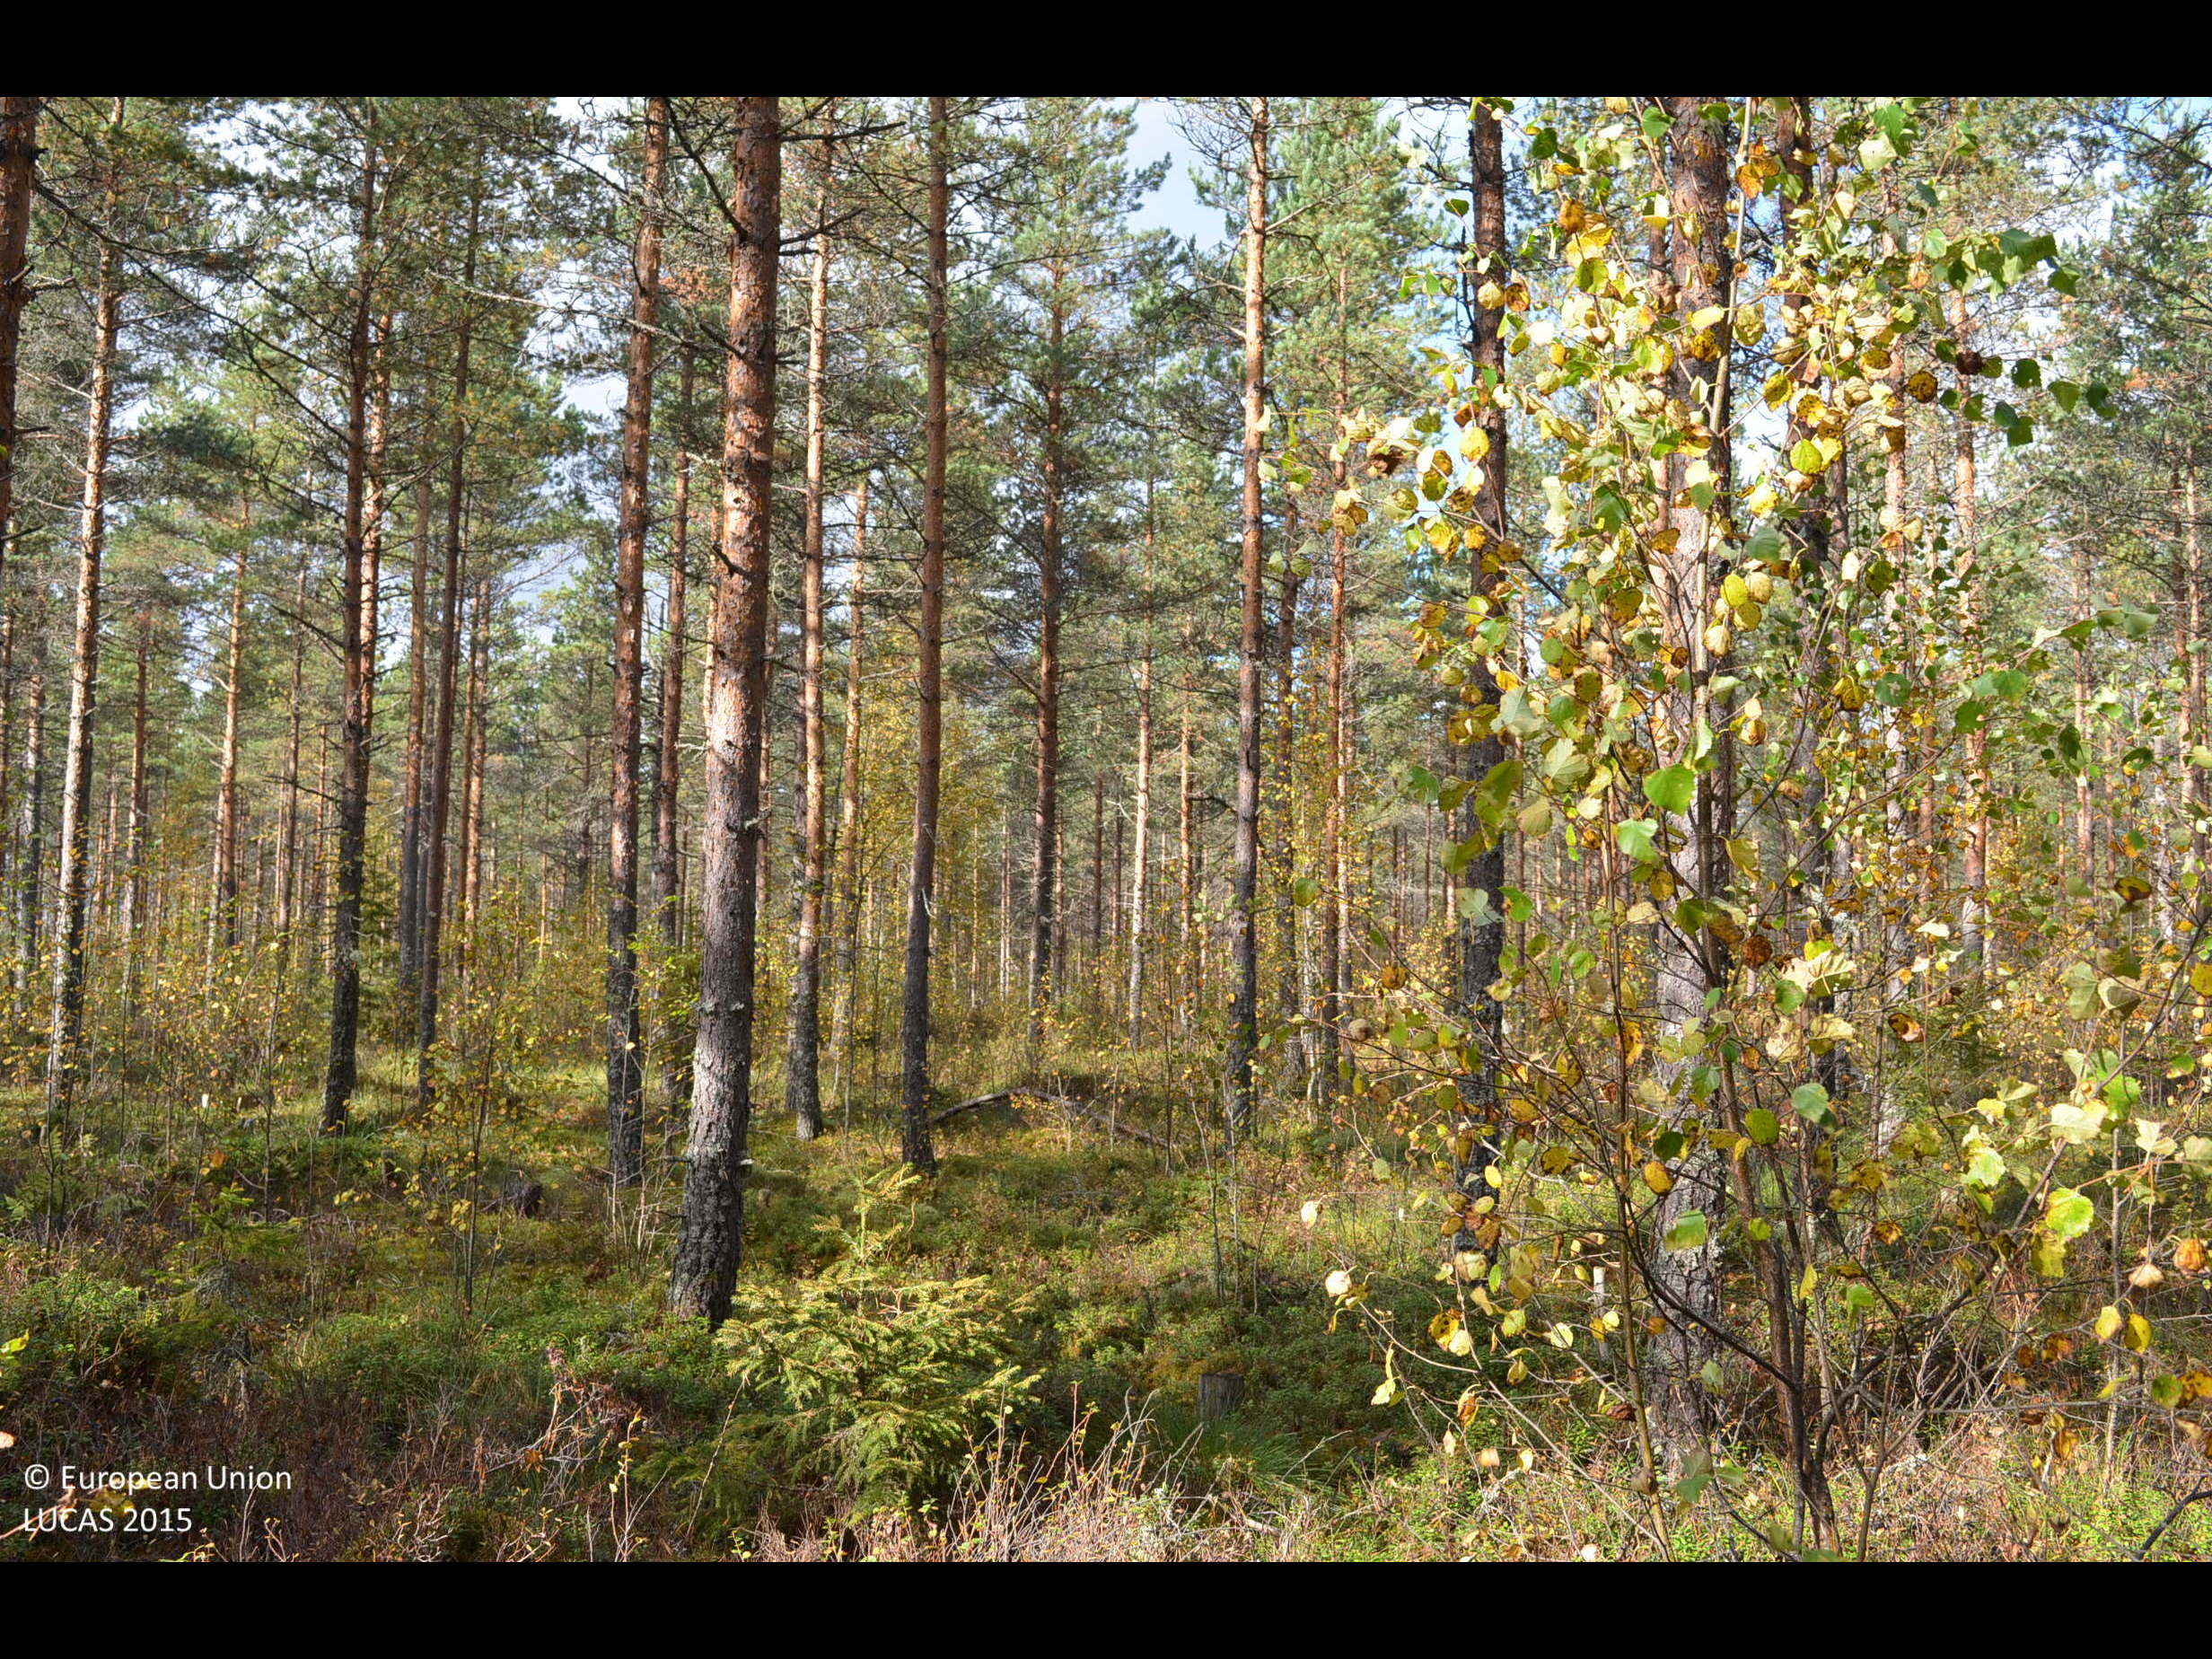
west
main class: Woodland
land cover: Pine dominated coniferous woodland
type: boreal forest
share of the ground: > 75 %
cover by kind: coniferous forest trees 60 %, shrubs 20 %, broadleaved forest trees 15 %, herbaceous plants 5 %
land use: Forestry
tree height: > 5 m
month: September
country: FI
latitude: 62.9206
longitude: 23.8767
